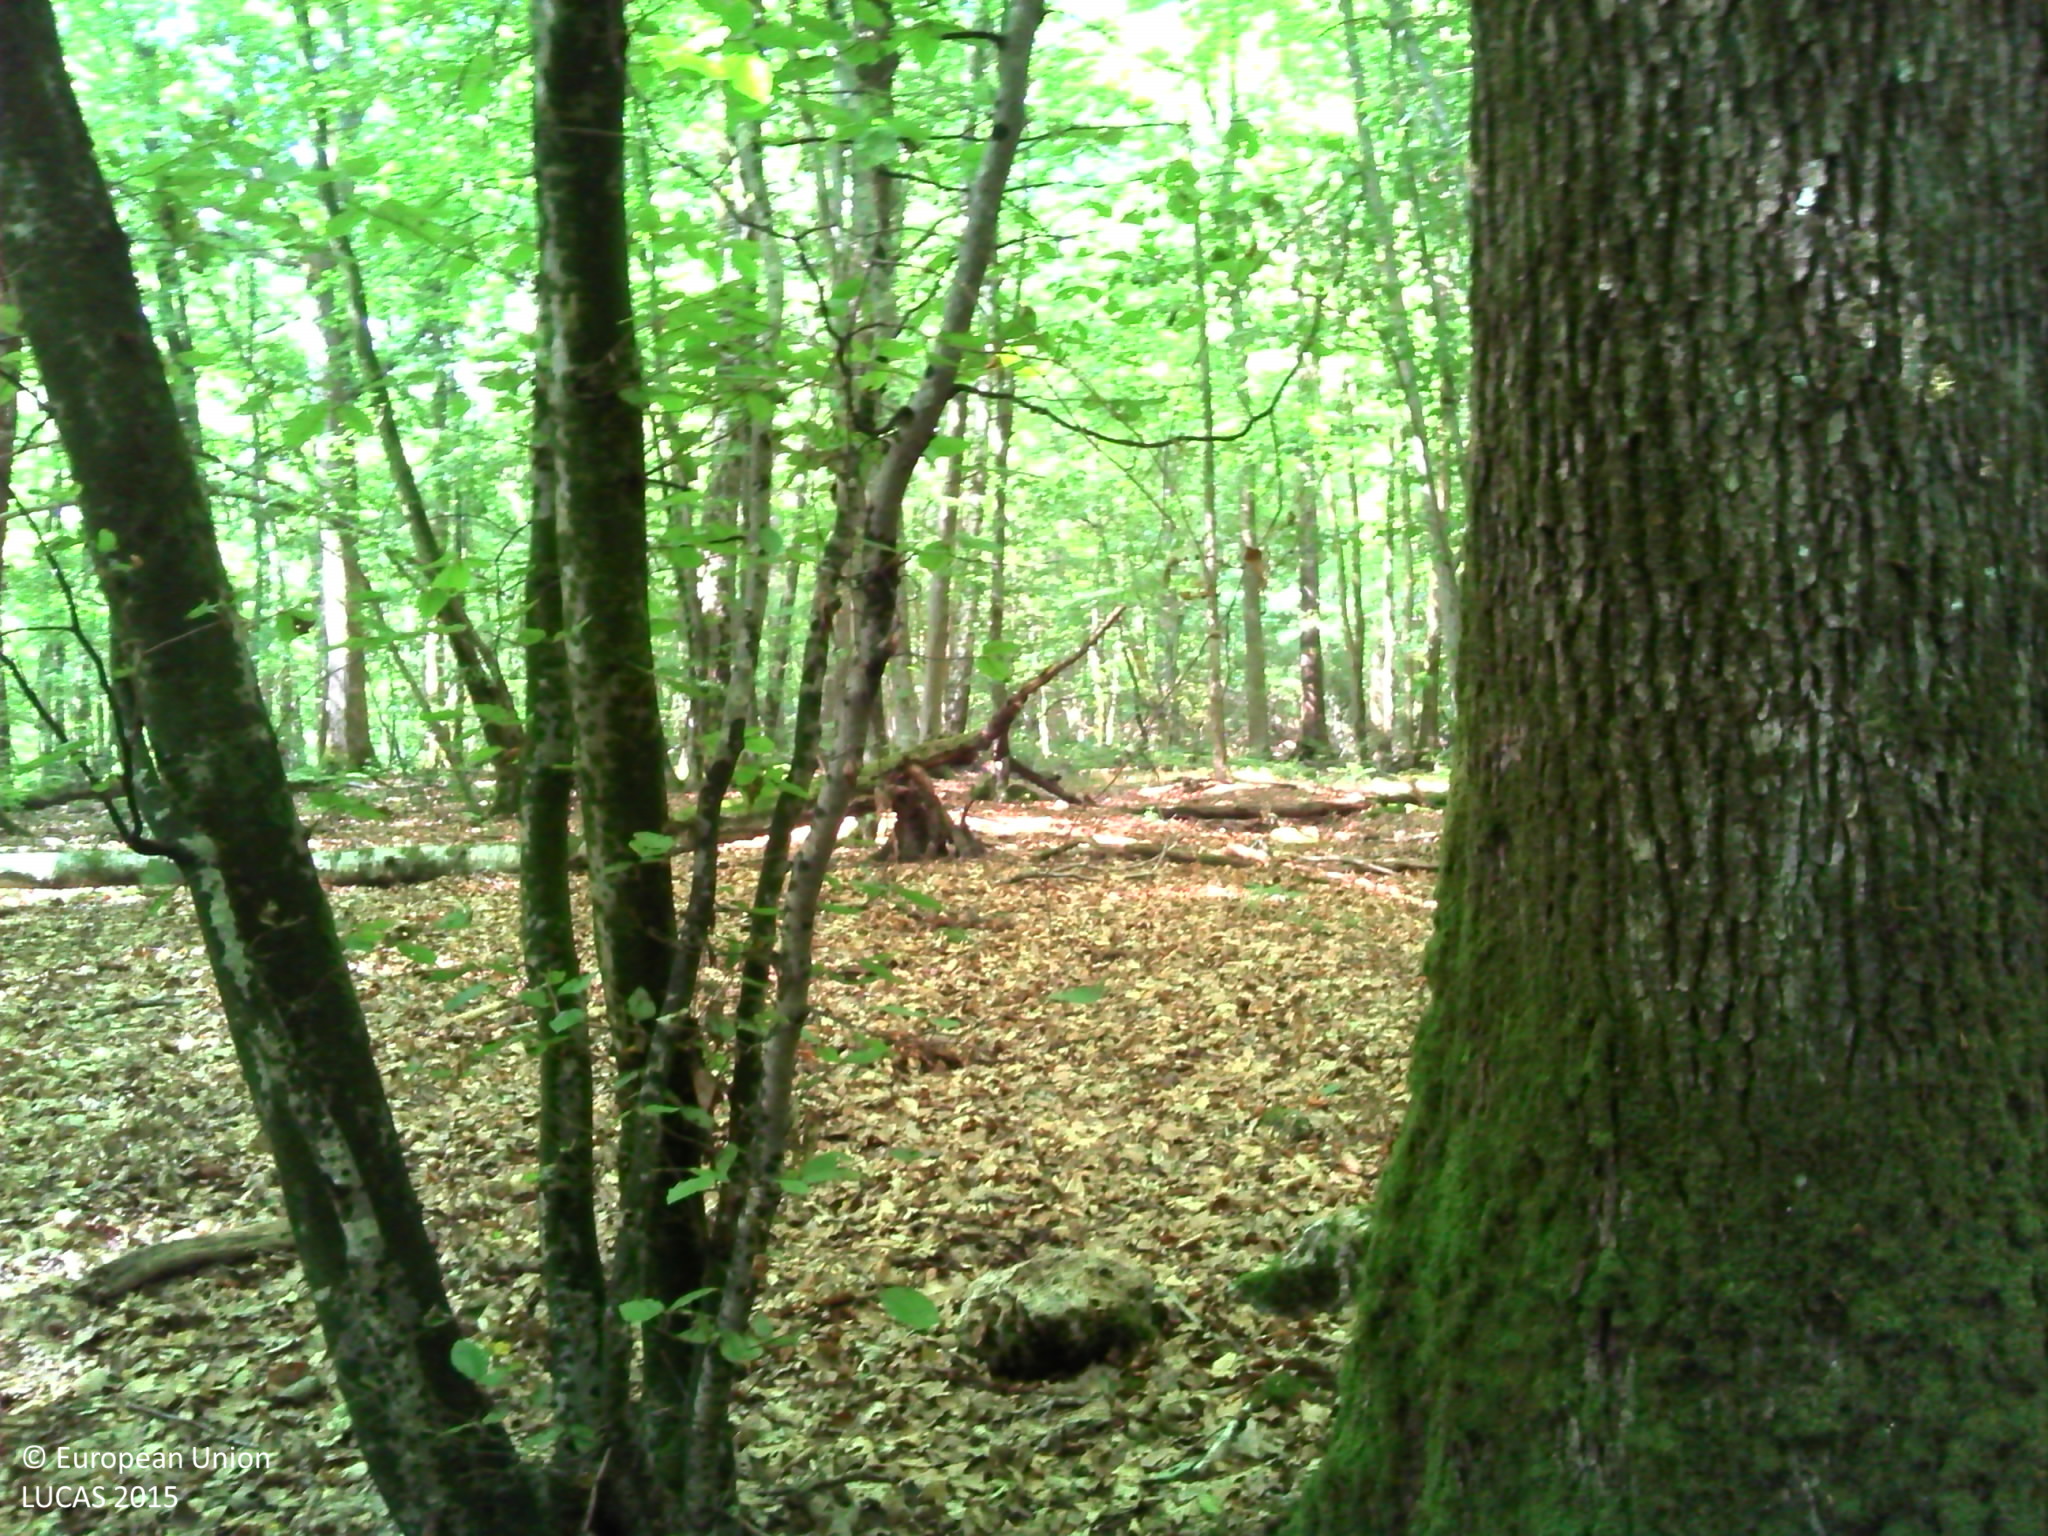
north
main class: Woodland
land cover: Broadleaved woodland
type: acidophilous oak and oak-birch forest
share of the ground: > 75 %
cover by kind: broadleaved forest trees 40 %, herbaceous plants 25 %, unconsolidated bare surface 20 %, coniferous forest trees 5 %, lichens and mosses 5 %
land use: Forestry
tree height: > 5 m
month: August
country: FR
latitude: 49.1307
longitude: 4.1160
